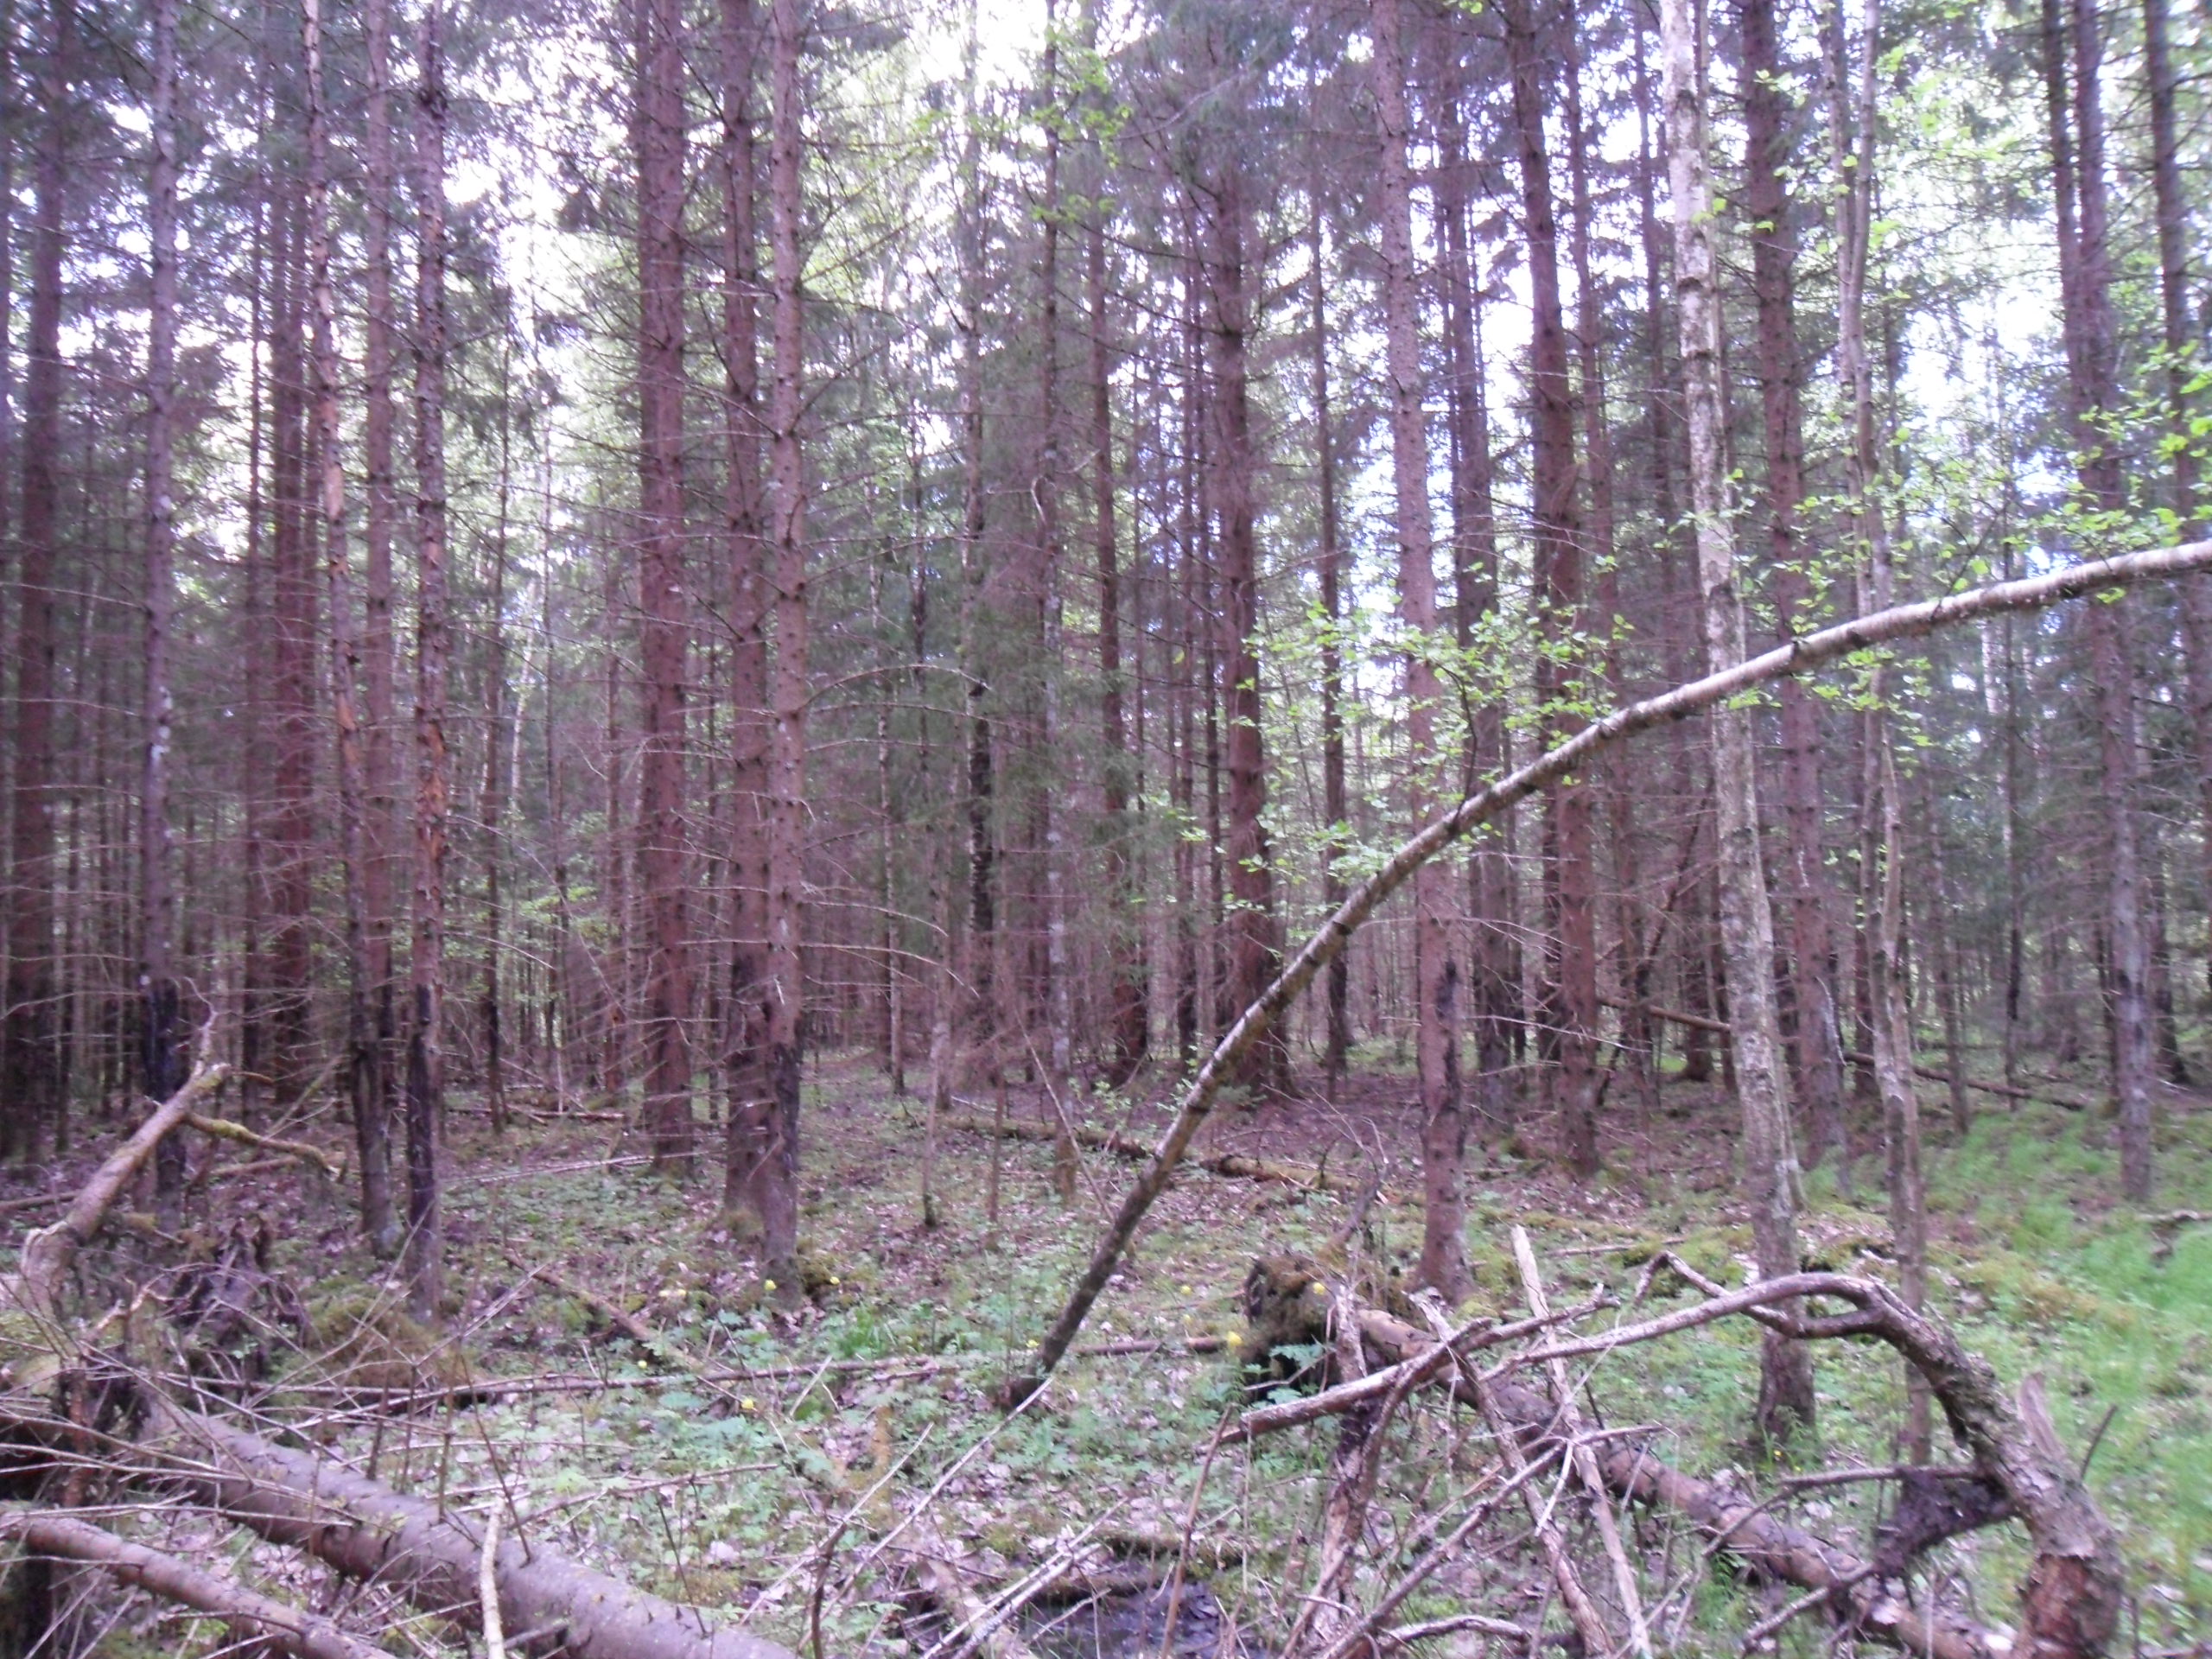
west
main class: Woodland
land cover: Spruce dominated mixed woodland
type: hemiboreal forest and nemoral coniferous forest and mixed broadleaved-coniferous forest
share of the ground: > 75 %
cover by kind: coniferous forest trees 60 %, broadleaved forest trees 40 %
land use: Forestry
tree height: > 5 m
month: May
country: LV
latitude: 57.2739
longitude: 22.4417
